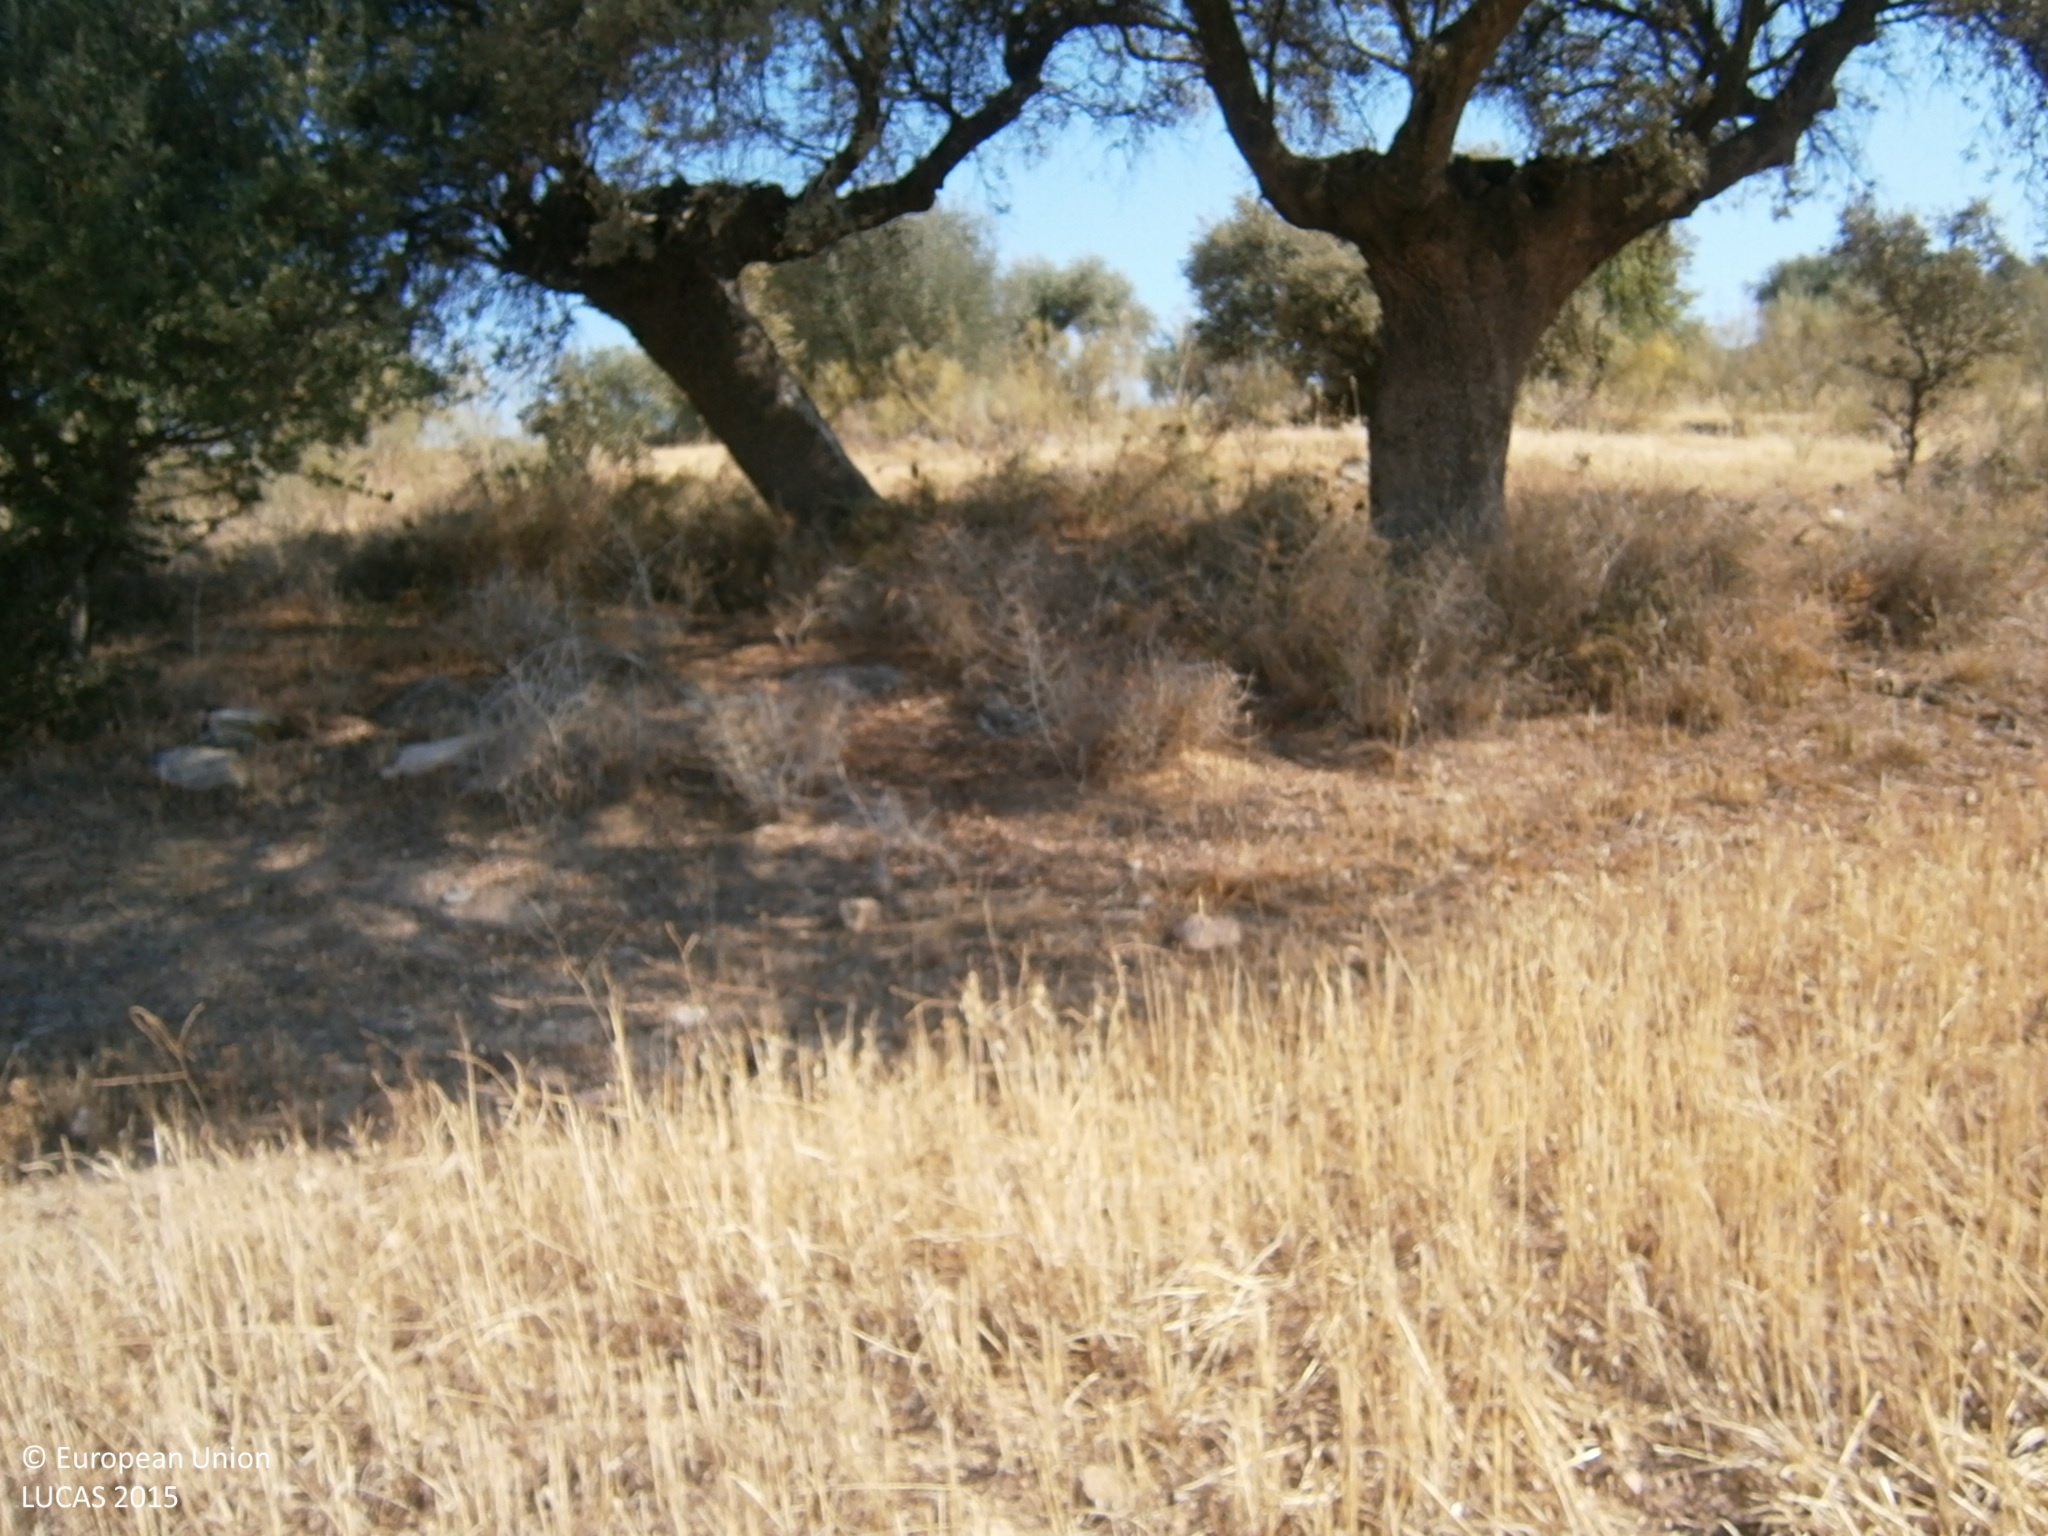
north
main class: Cropland
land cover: Dry pulses
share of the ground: > 75 %
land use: Agriculture (excluding fallow land and kitchen gardens)
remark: Harvested field
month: June
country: ES
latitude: 38.5781
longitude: -6.7382
